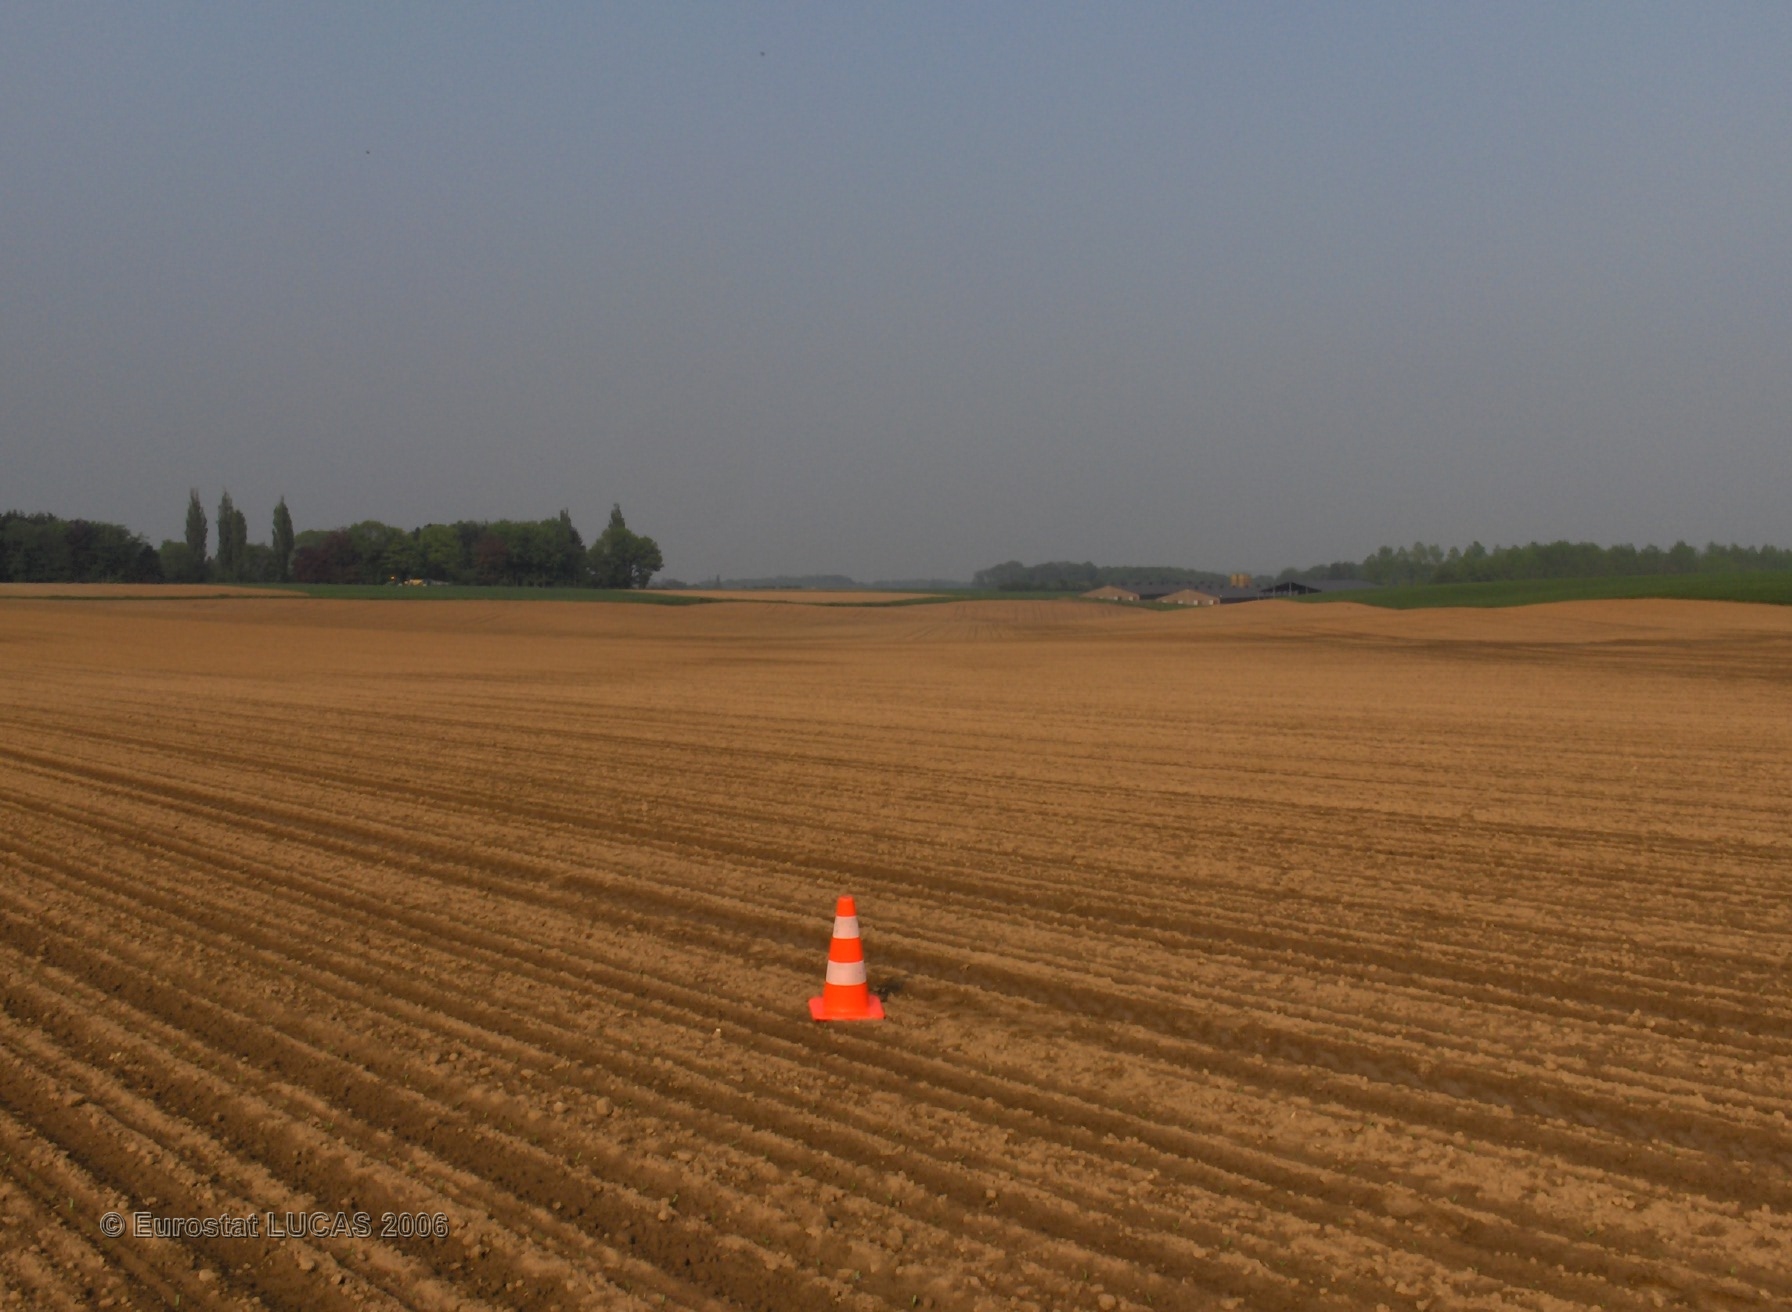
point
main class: Cropland
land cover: Sugar beet
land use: Agriculture (excluding fallow land and kitchen gardens)
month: May
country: BE
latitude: 50.6832
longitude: 4.5185
